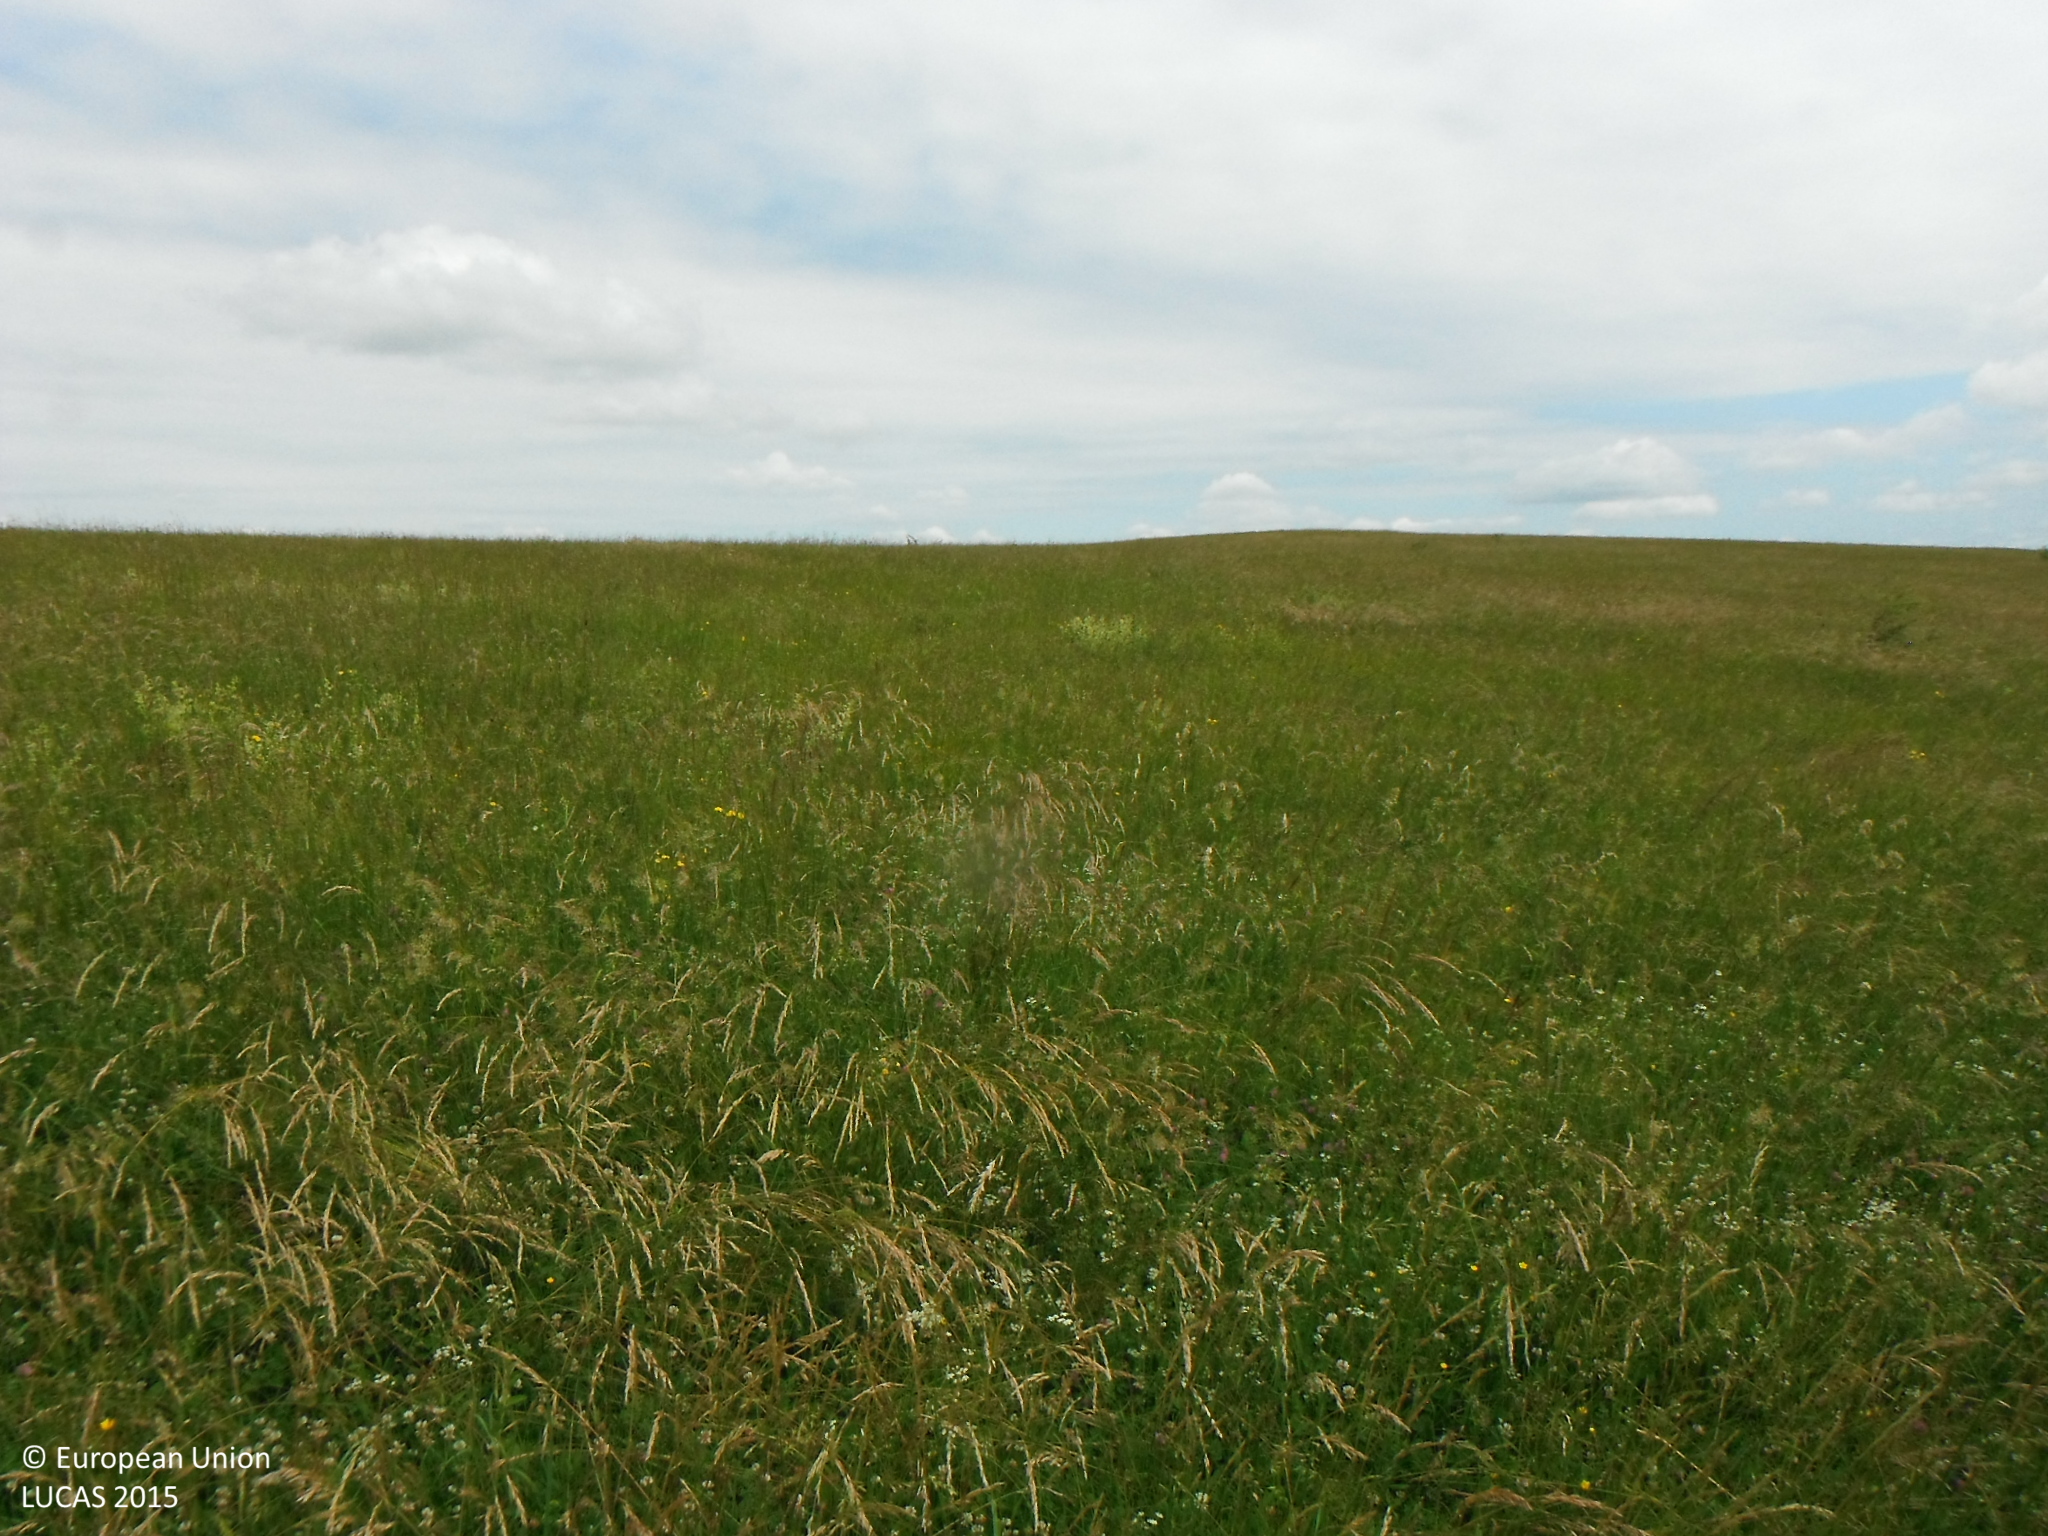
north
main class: Grassland
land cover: Grassland without tree/shrub cover
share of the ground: > 75 %
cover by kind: herbaceous plants 100 %
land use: Agriculture (excluding fallow land and kitchen gardens)
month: June
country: SK
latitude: 49.1015
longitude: 21.4020
